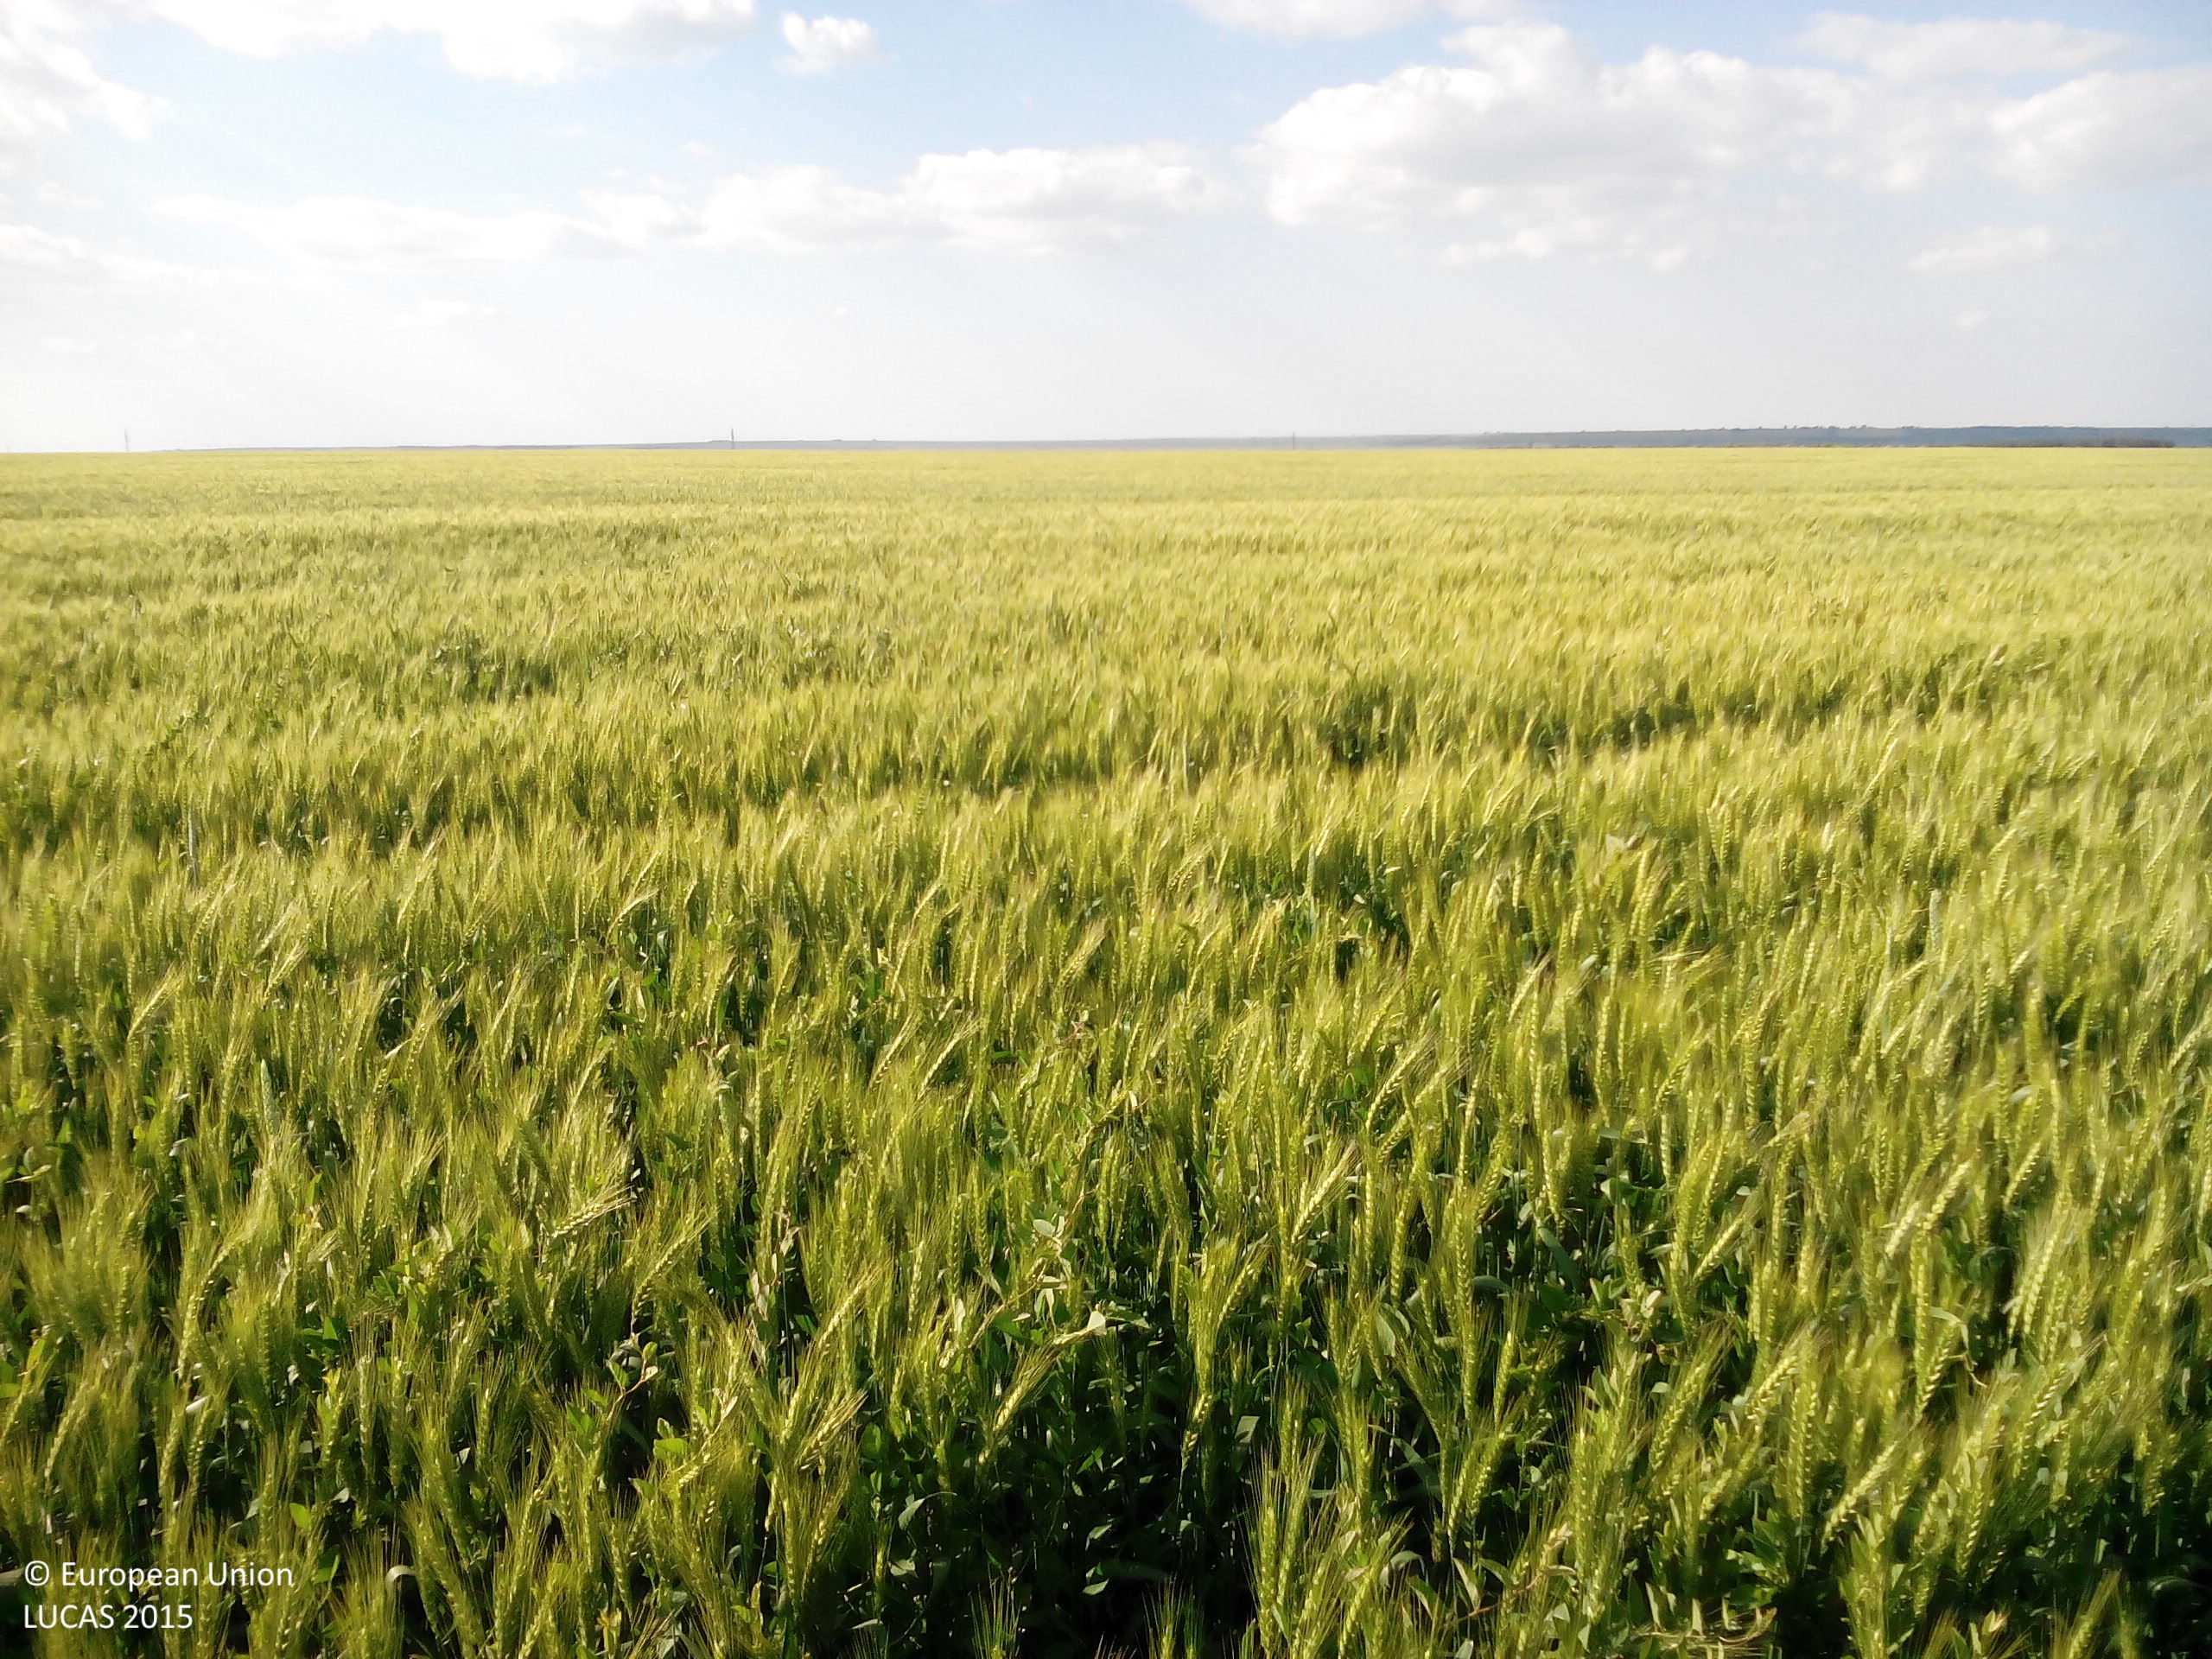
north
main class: Cropland
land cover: Common wheat
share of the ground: > 75 %
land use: Agriculture (excluding fallow land and kitchen gardens)
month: May
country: BG
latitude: 43.4704
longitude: 23.8578
